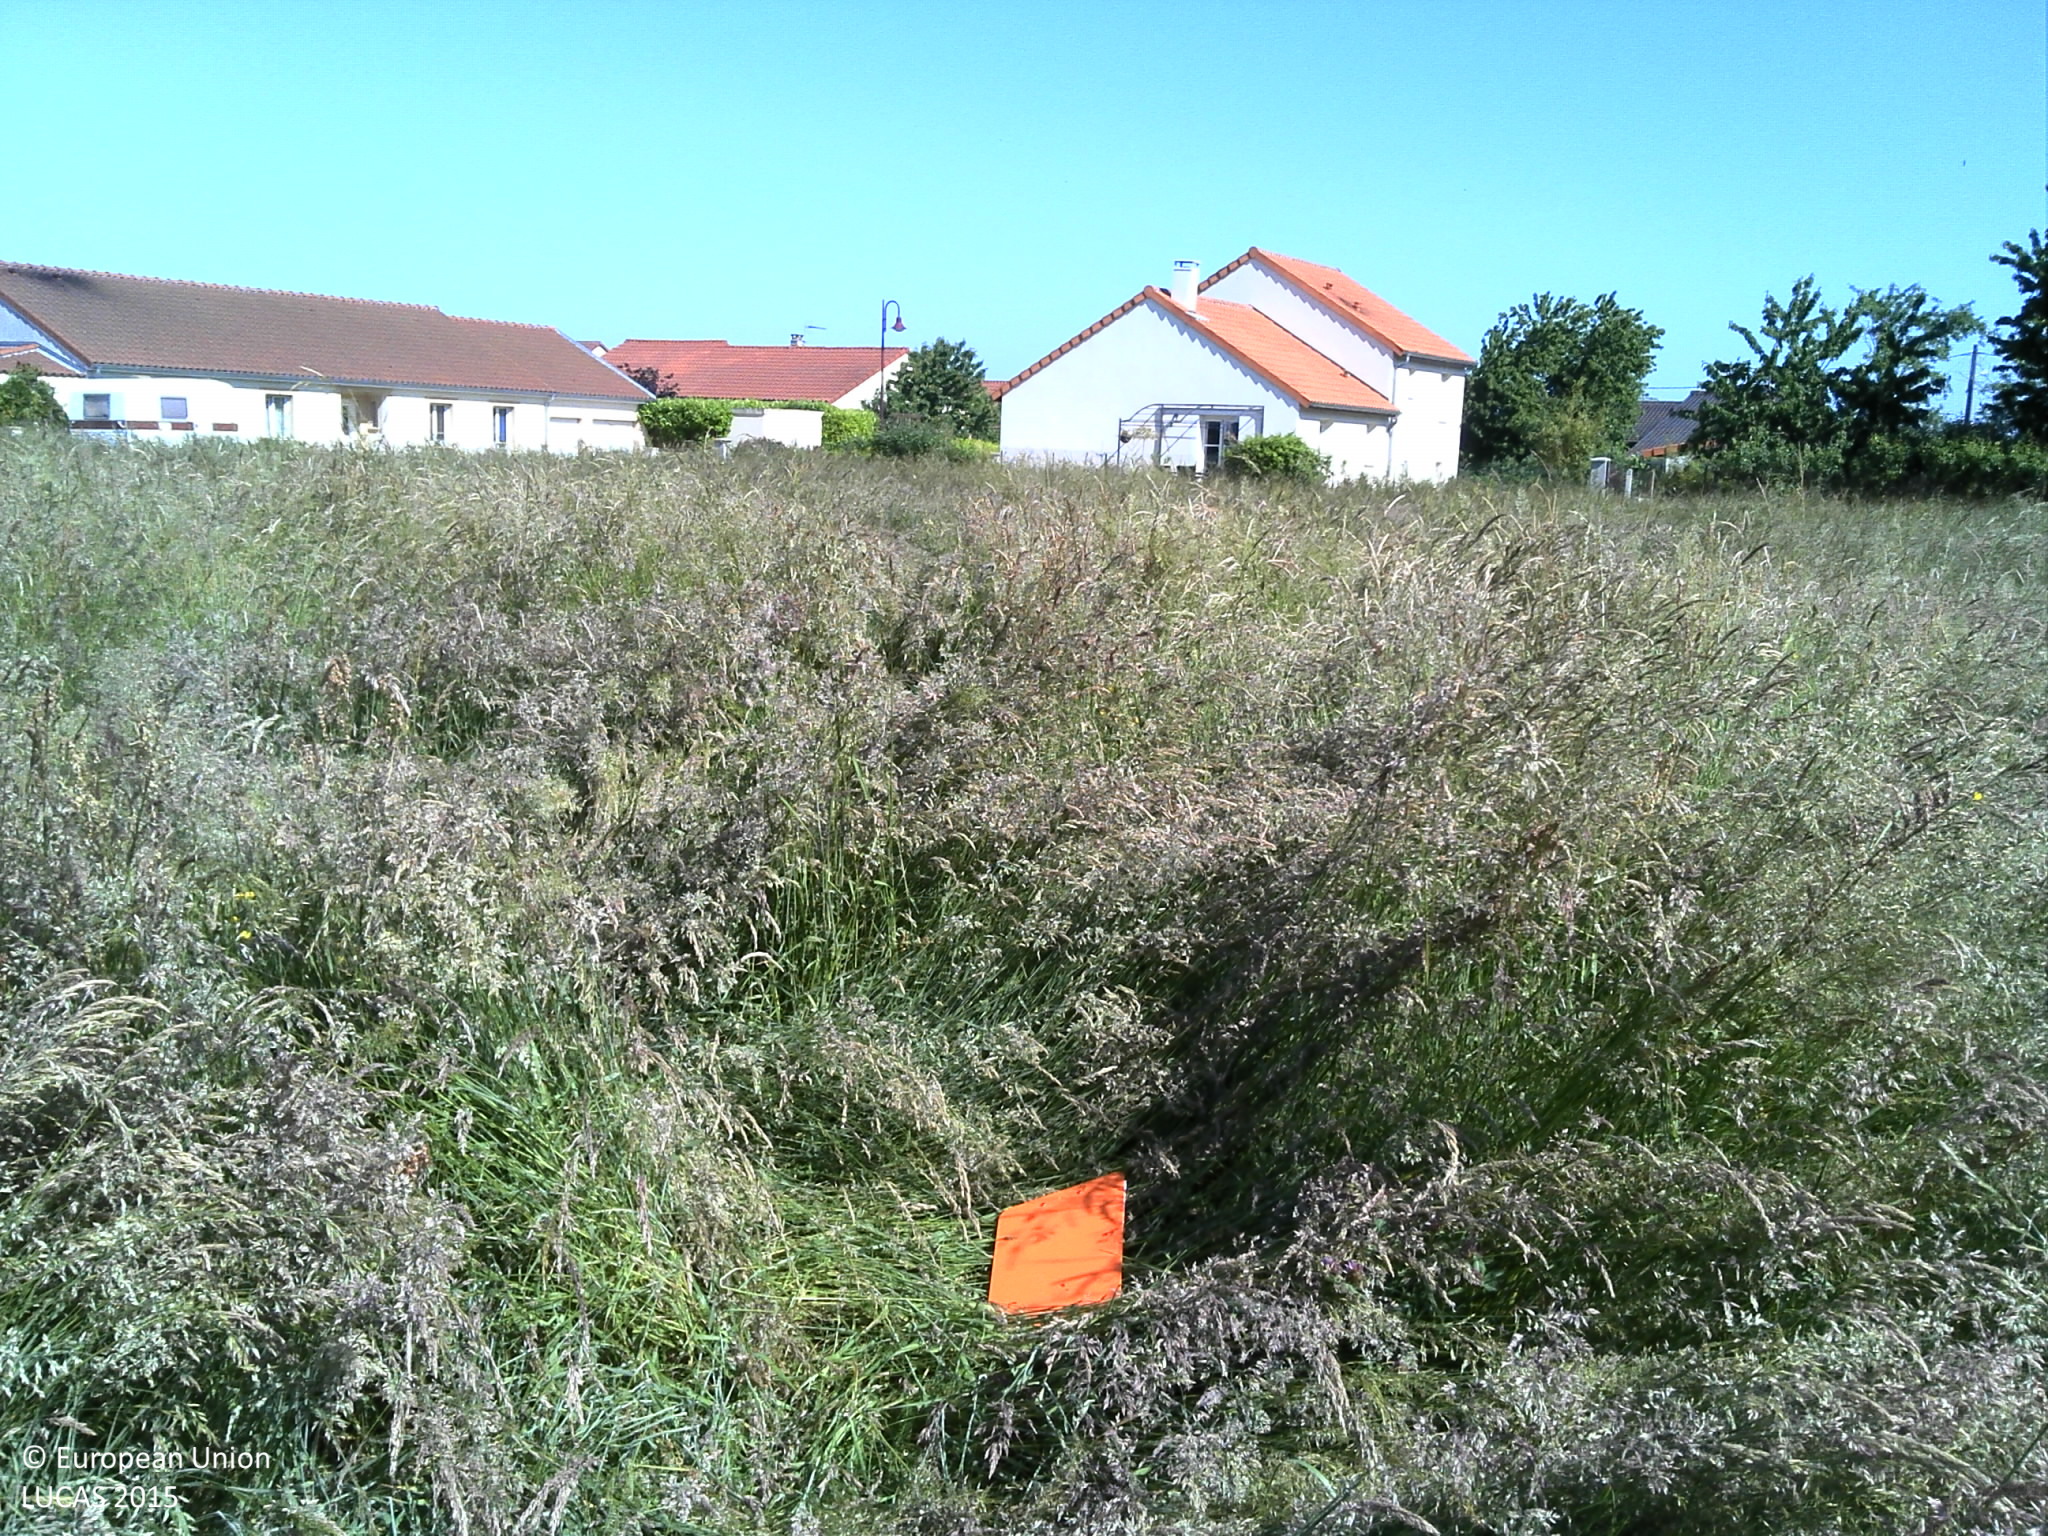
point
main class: Grassland
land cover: Grassland without tree/shrub cover
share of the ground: > 75 %
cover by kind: herbaceous plants 100 %
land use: Agriculture (excluding fallow land and kitchen gardens)
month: June
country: FR
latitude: 48.9484
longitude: 6.1355
